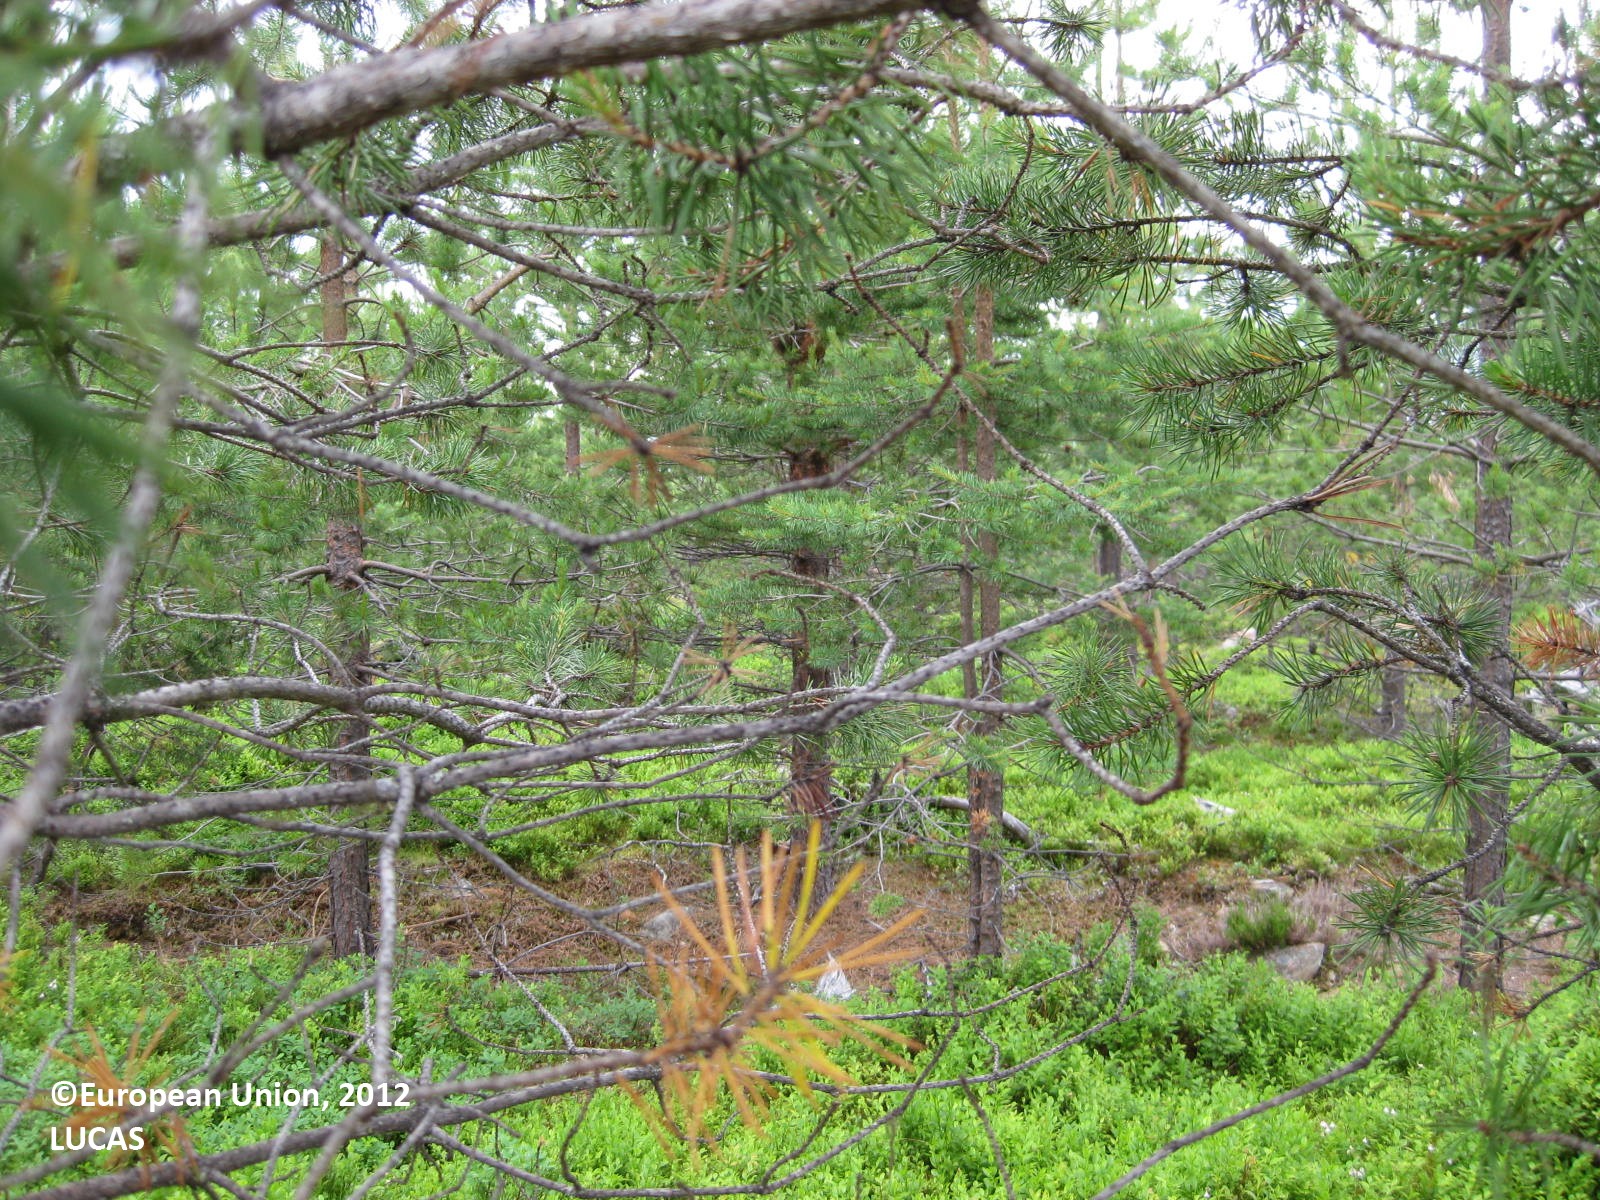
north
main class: Woodland
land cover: Pine dominated coniferous woodland
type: boreal forest
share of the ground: 50 - 75 %
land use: Forestry
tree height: > 5 m
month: July
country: FI
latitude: 65.7513
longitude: 29.5517
